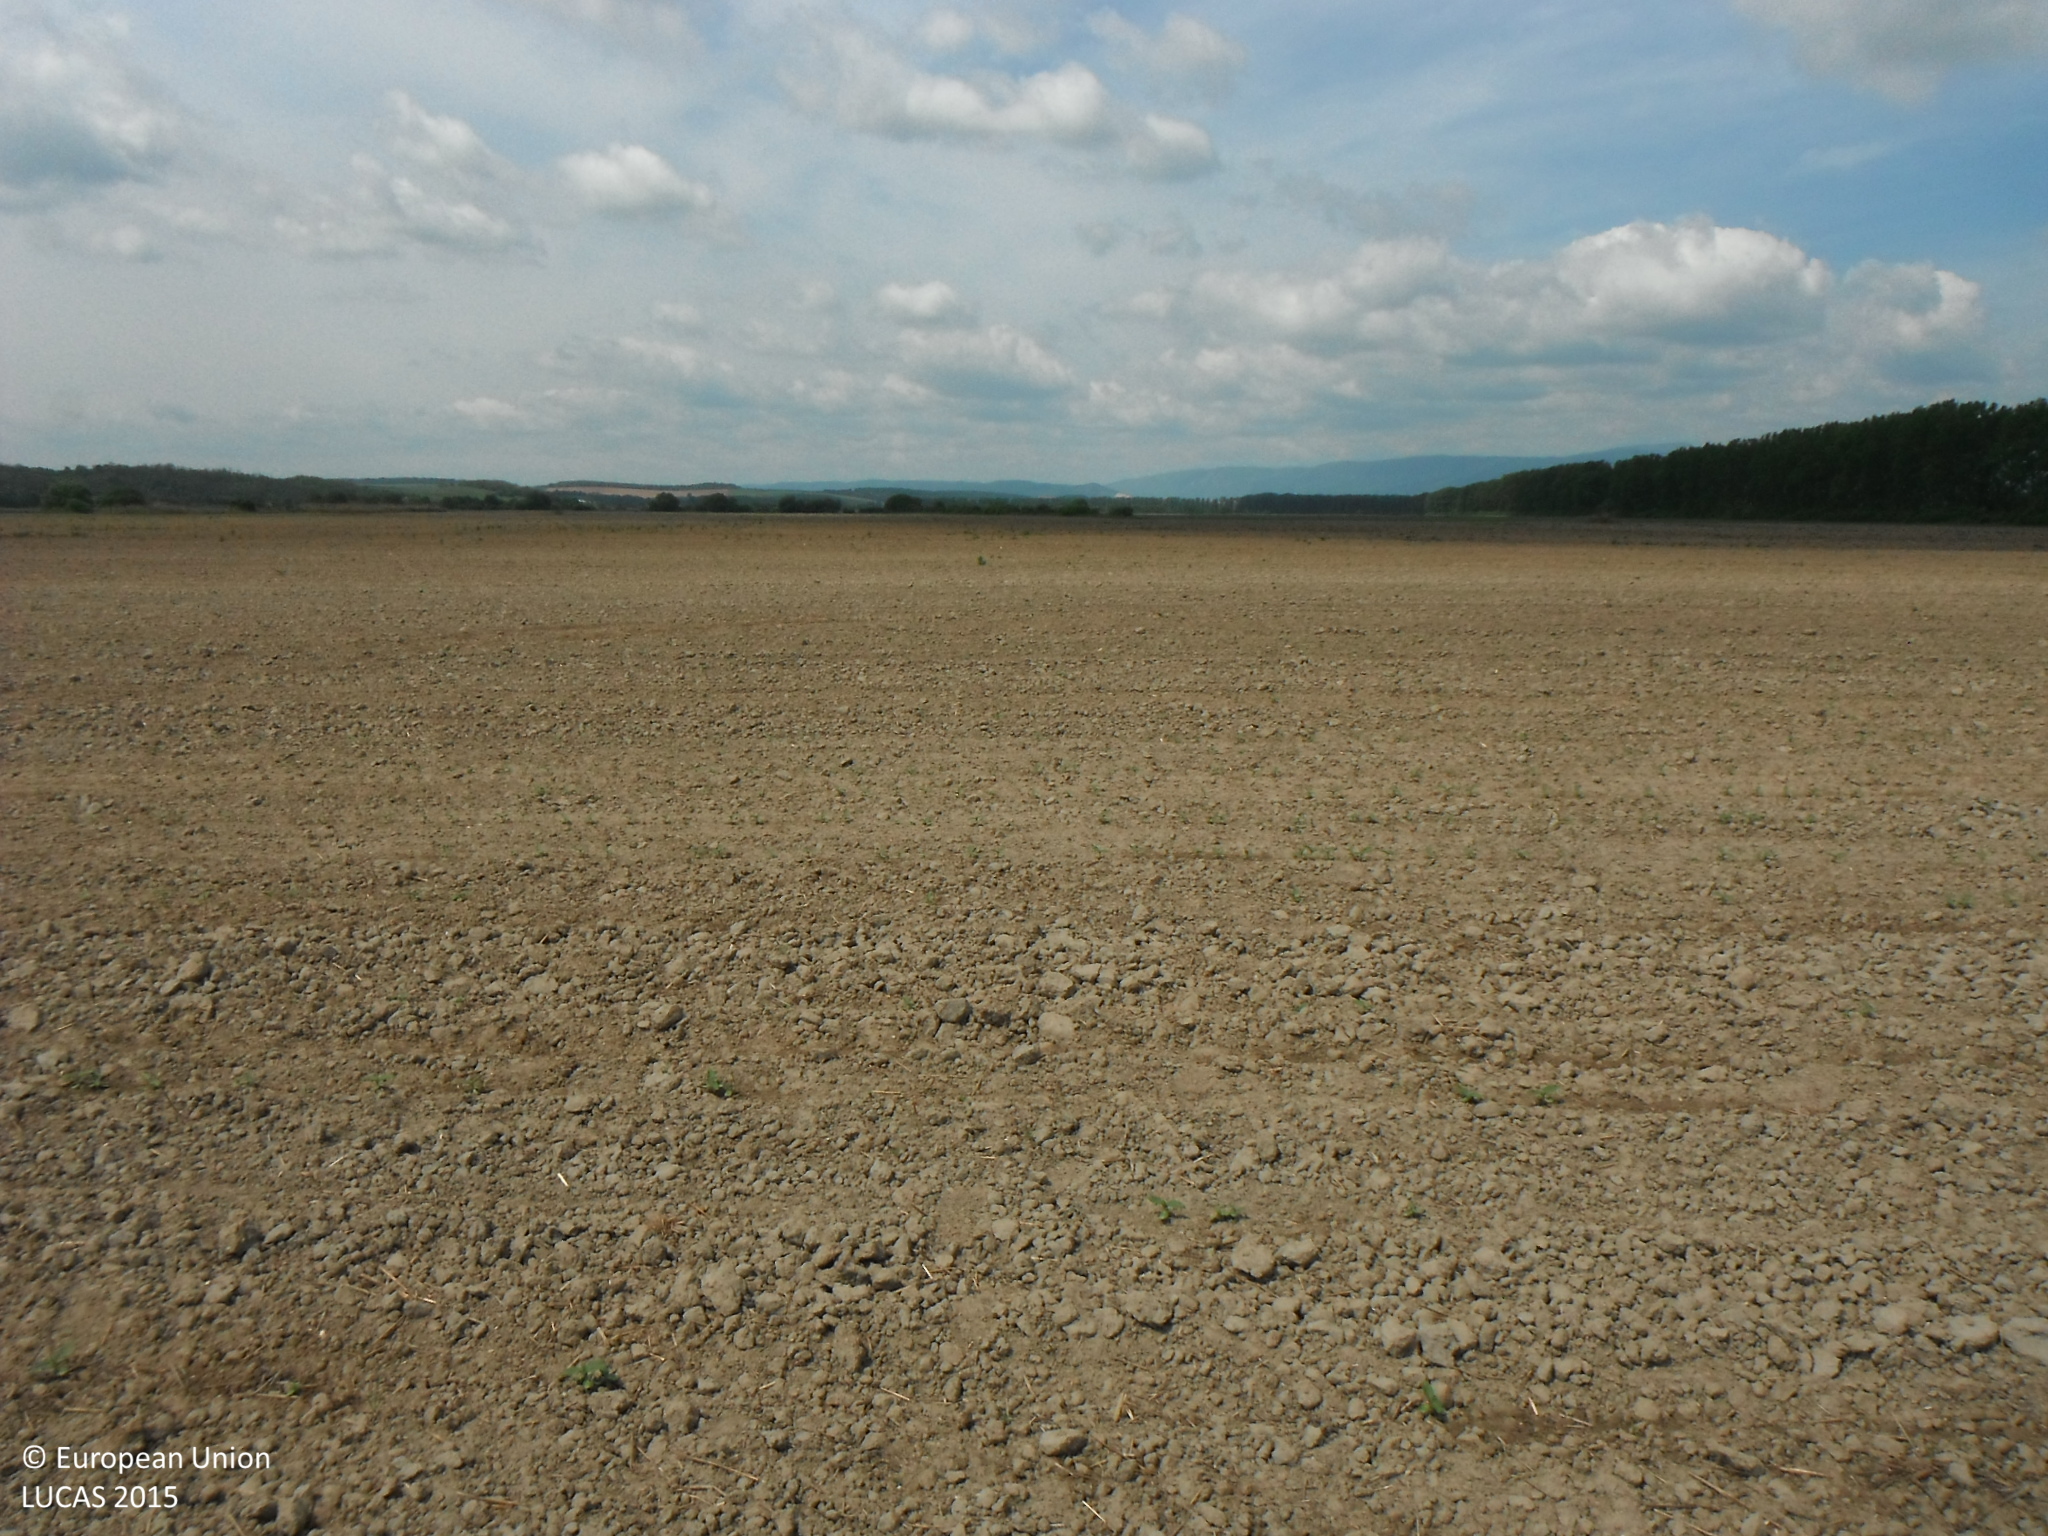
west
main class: Cropland
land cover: Sunflower
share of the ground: < 10 %
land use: Agriculture (excluding fallow land and kitchen gardens)
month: May
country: SK
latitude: 48.5581
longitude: 21.0296
